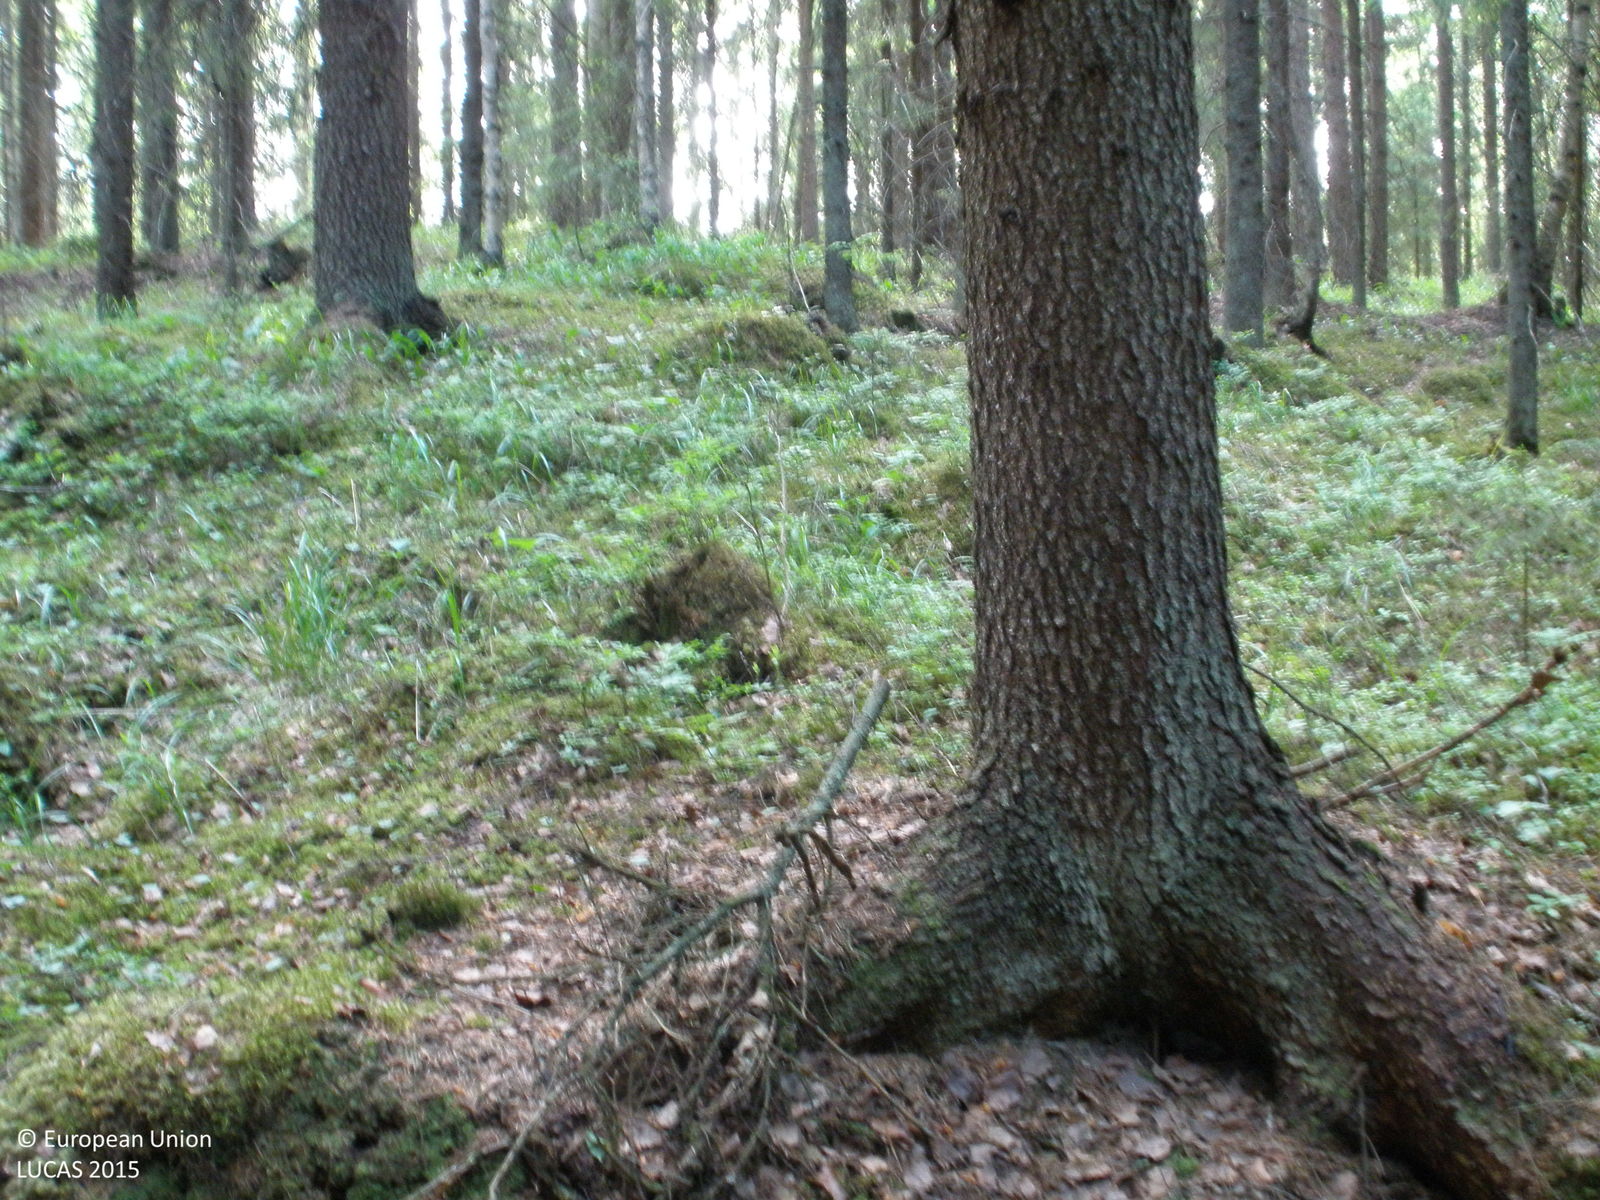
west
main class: Woodland
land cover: Spruce dominated coniferous woodland
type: boreal forest
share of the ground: > 75 %
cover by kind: coniferous forest trees 90 %, broadleaved forest trees 5 %, lichens and mosses 5 %
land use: Forestry
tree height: > 5 m
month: June
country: FI
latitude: 61.3006
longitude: 23.9212
